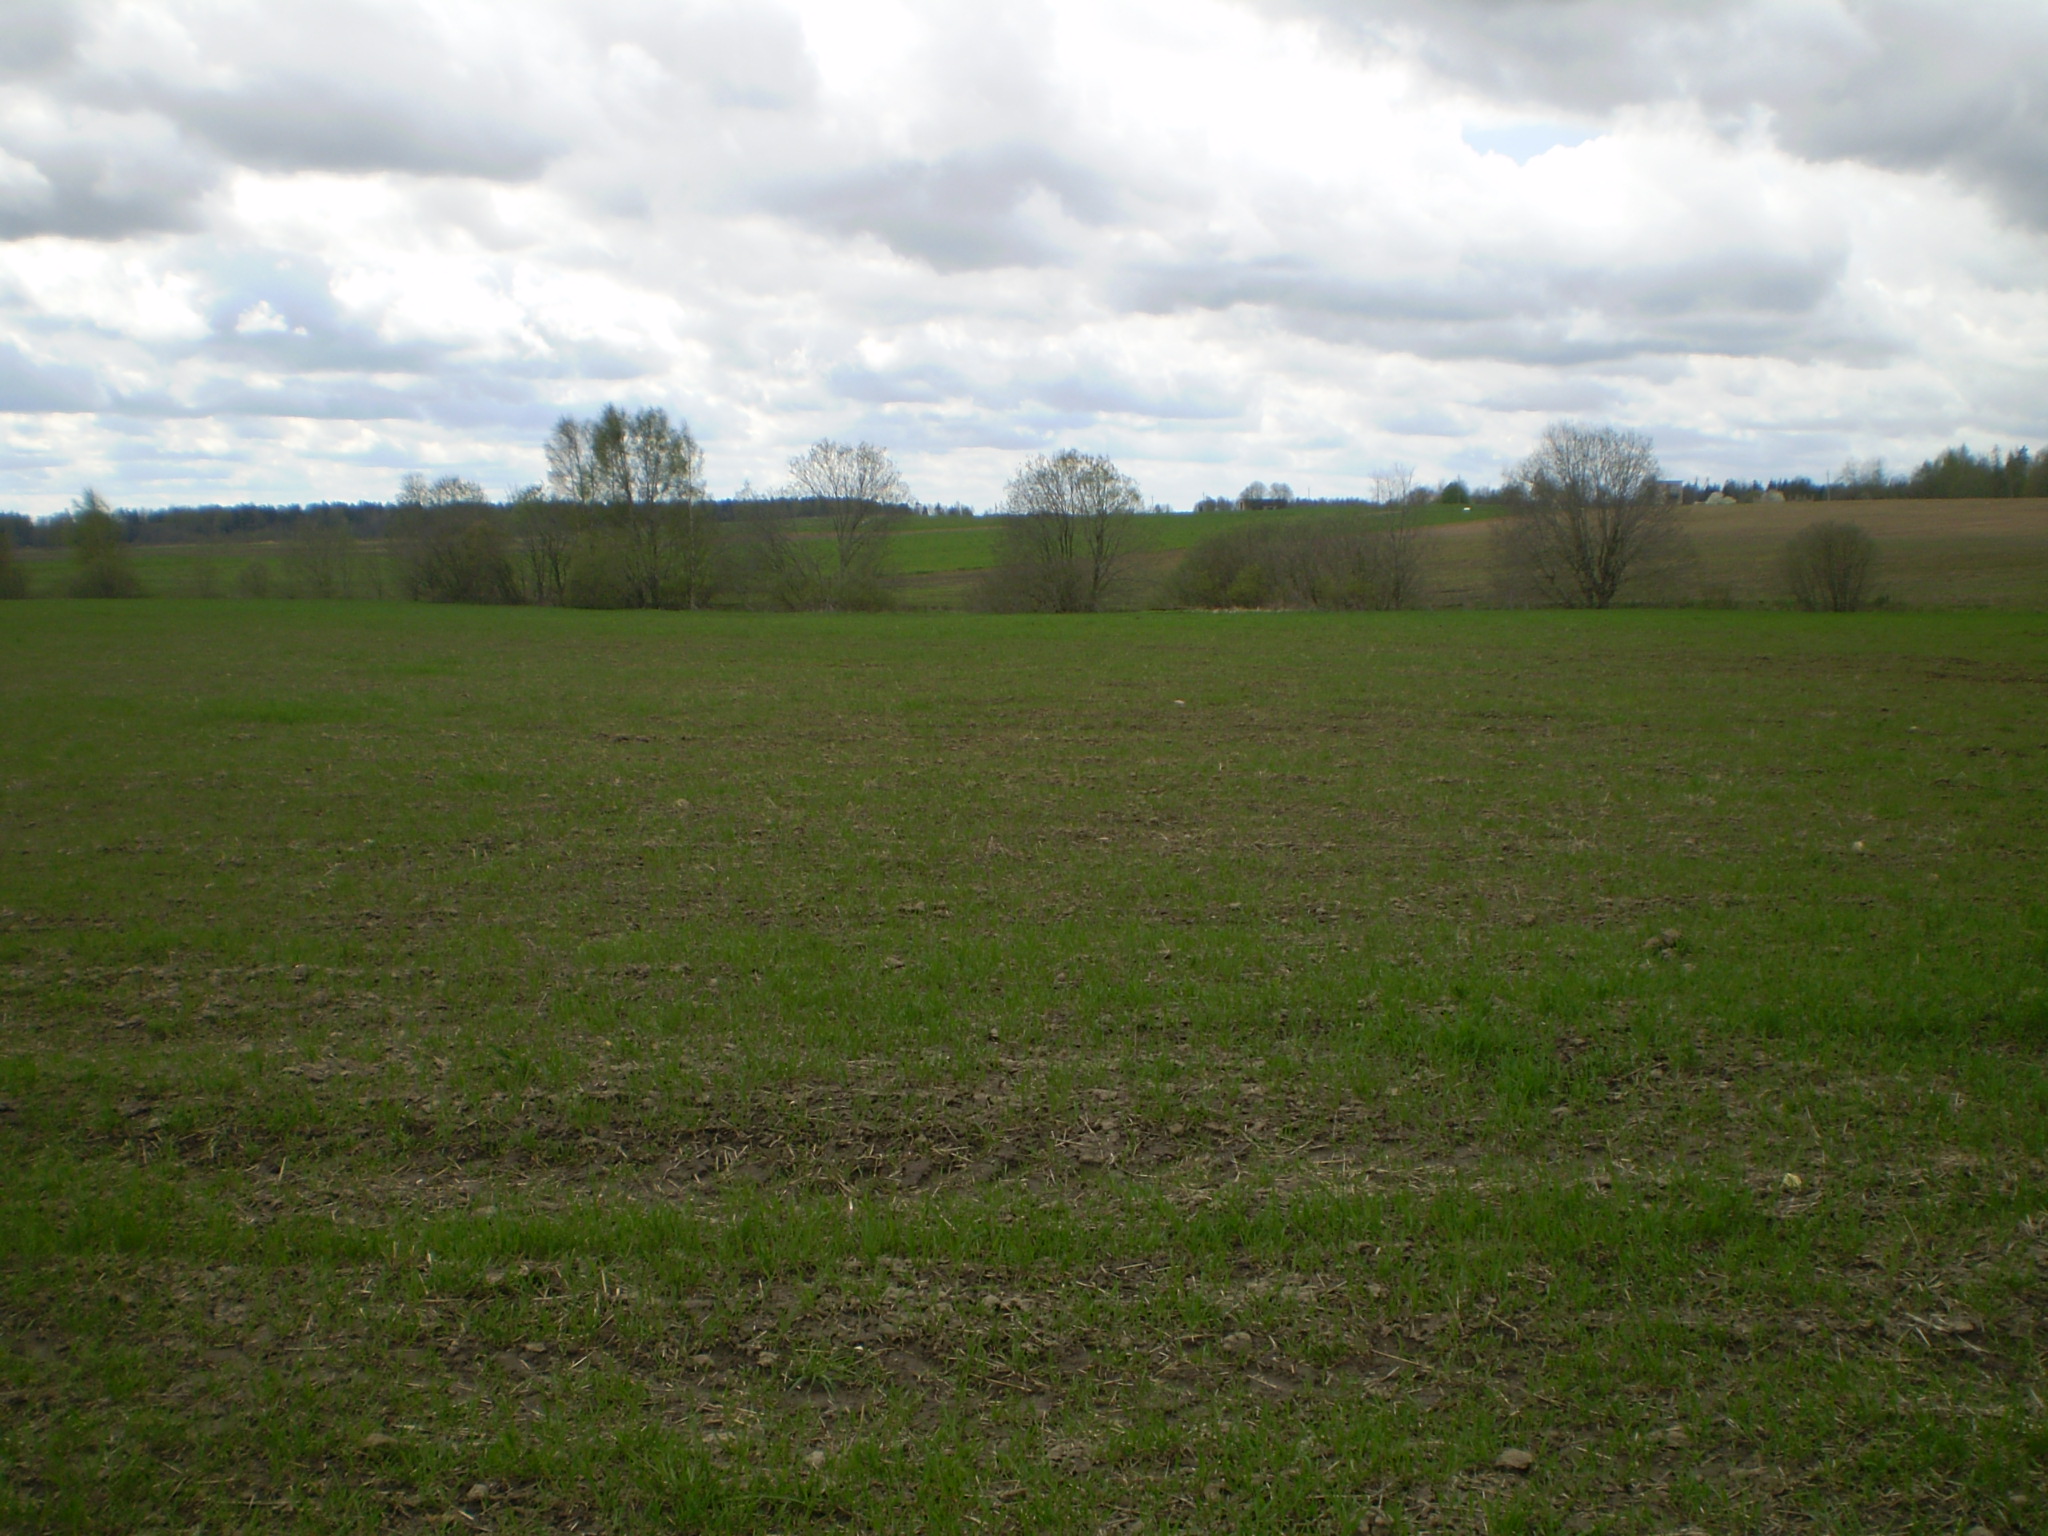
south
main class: Cropland
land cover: Common wheat
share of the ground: 50 - 75 %
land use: Agriculture (excluding fallow land and kitchen gardens)
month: May
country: LT
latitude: 56.4112
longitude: 22.1262
